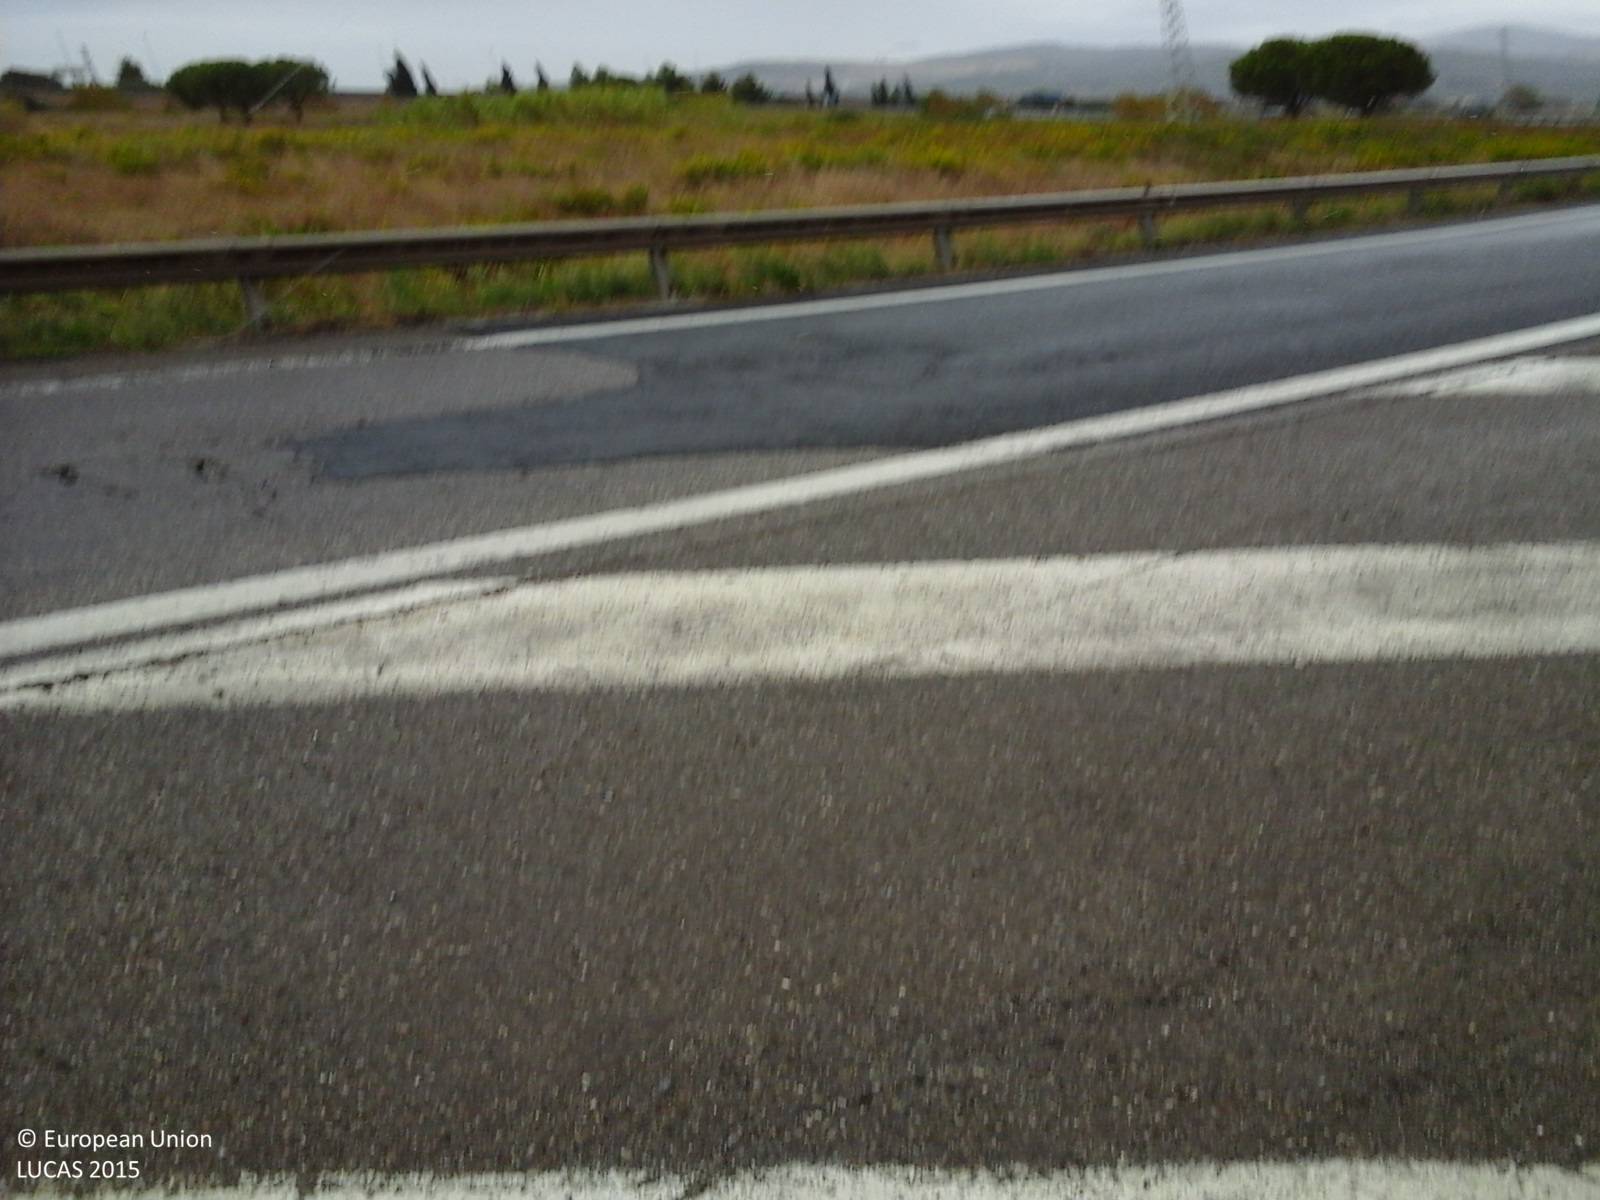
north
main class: Grassland
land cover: Grassland without tree/shrub cover
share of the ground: > 75 %
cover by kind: herbaceous plants 100 %
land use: Road transport
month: October
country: IT
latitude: 43.0134
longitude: 10.5993
